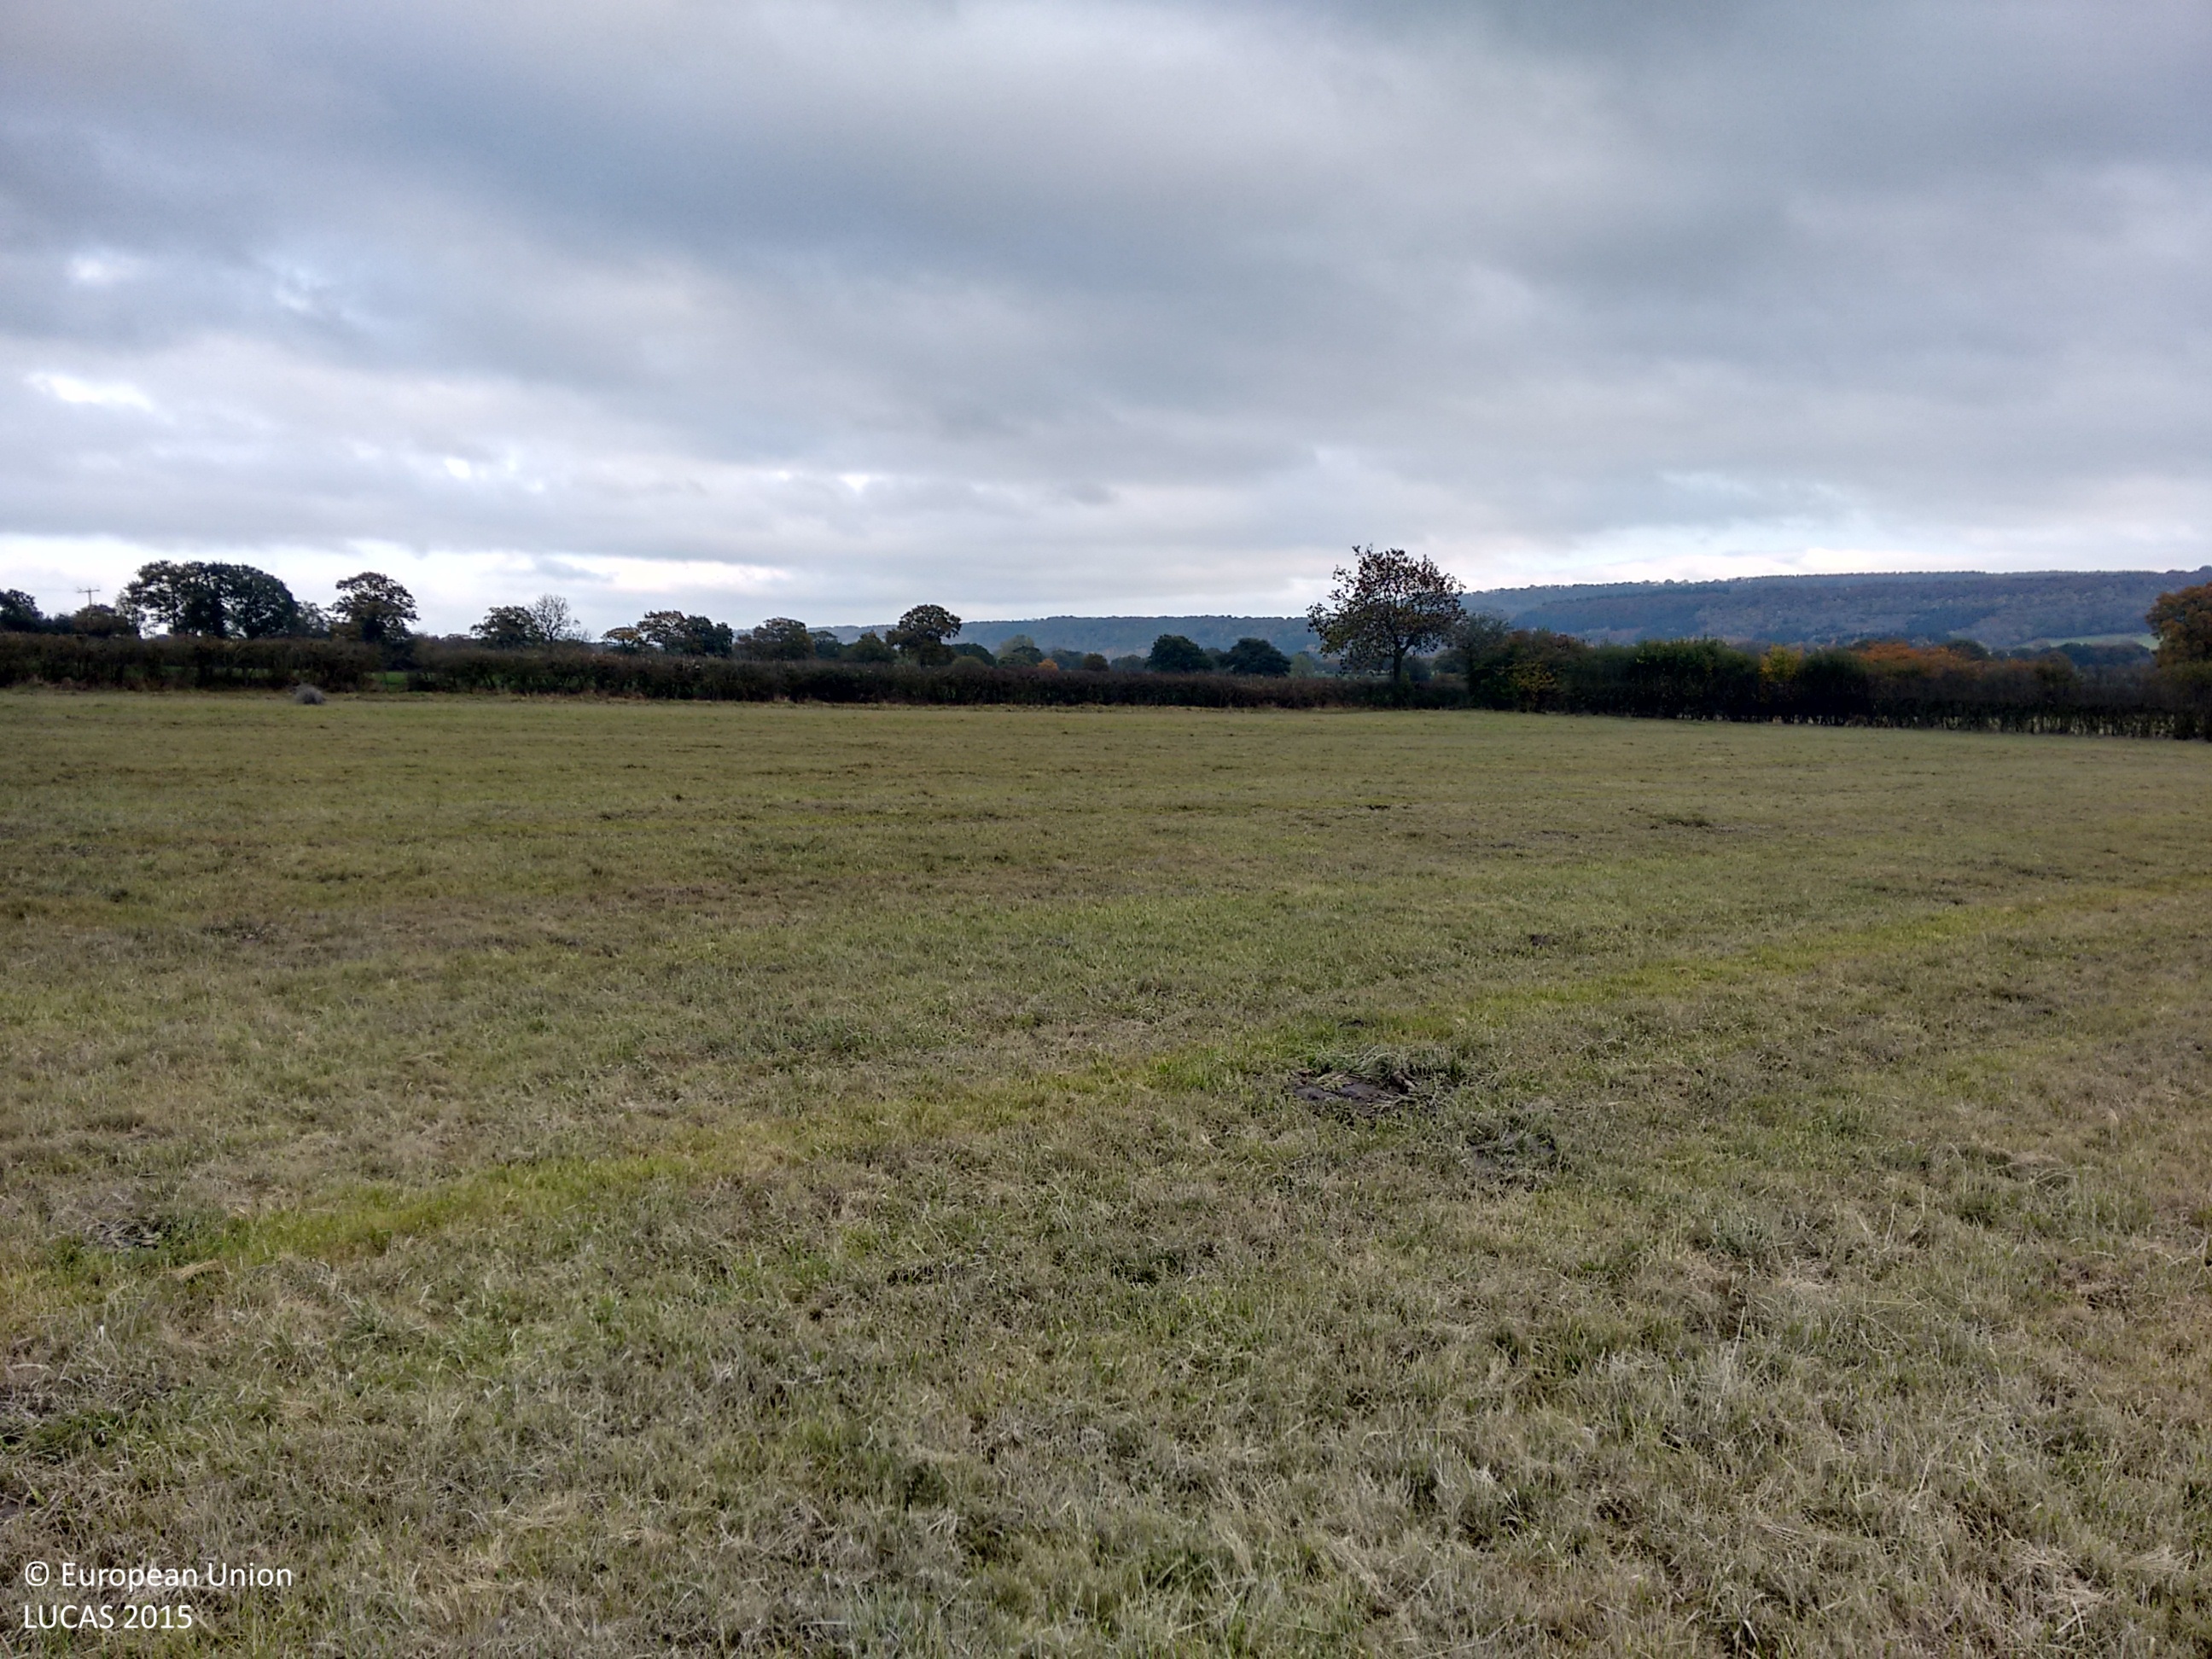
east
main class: Grassland
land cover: Grassland without tree/shrub cover
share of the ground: > 75 %
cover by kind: herbaceous plants 100 %
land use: Agriculture (excluding fallow land and kitchen gardens)
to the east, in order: Grassland without tree/shrub cover; Managed hedges; Grassland without tree/shrub cover
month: October
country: GB
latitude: 52.5022
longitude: -2.7844
